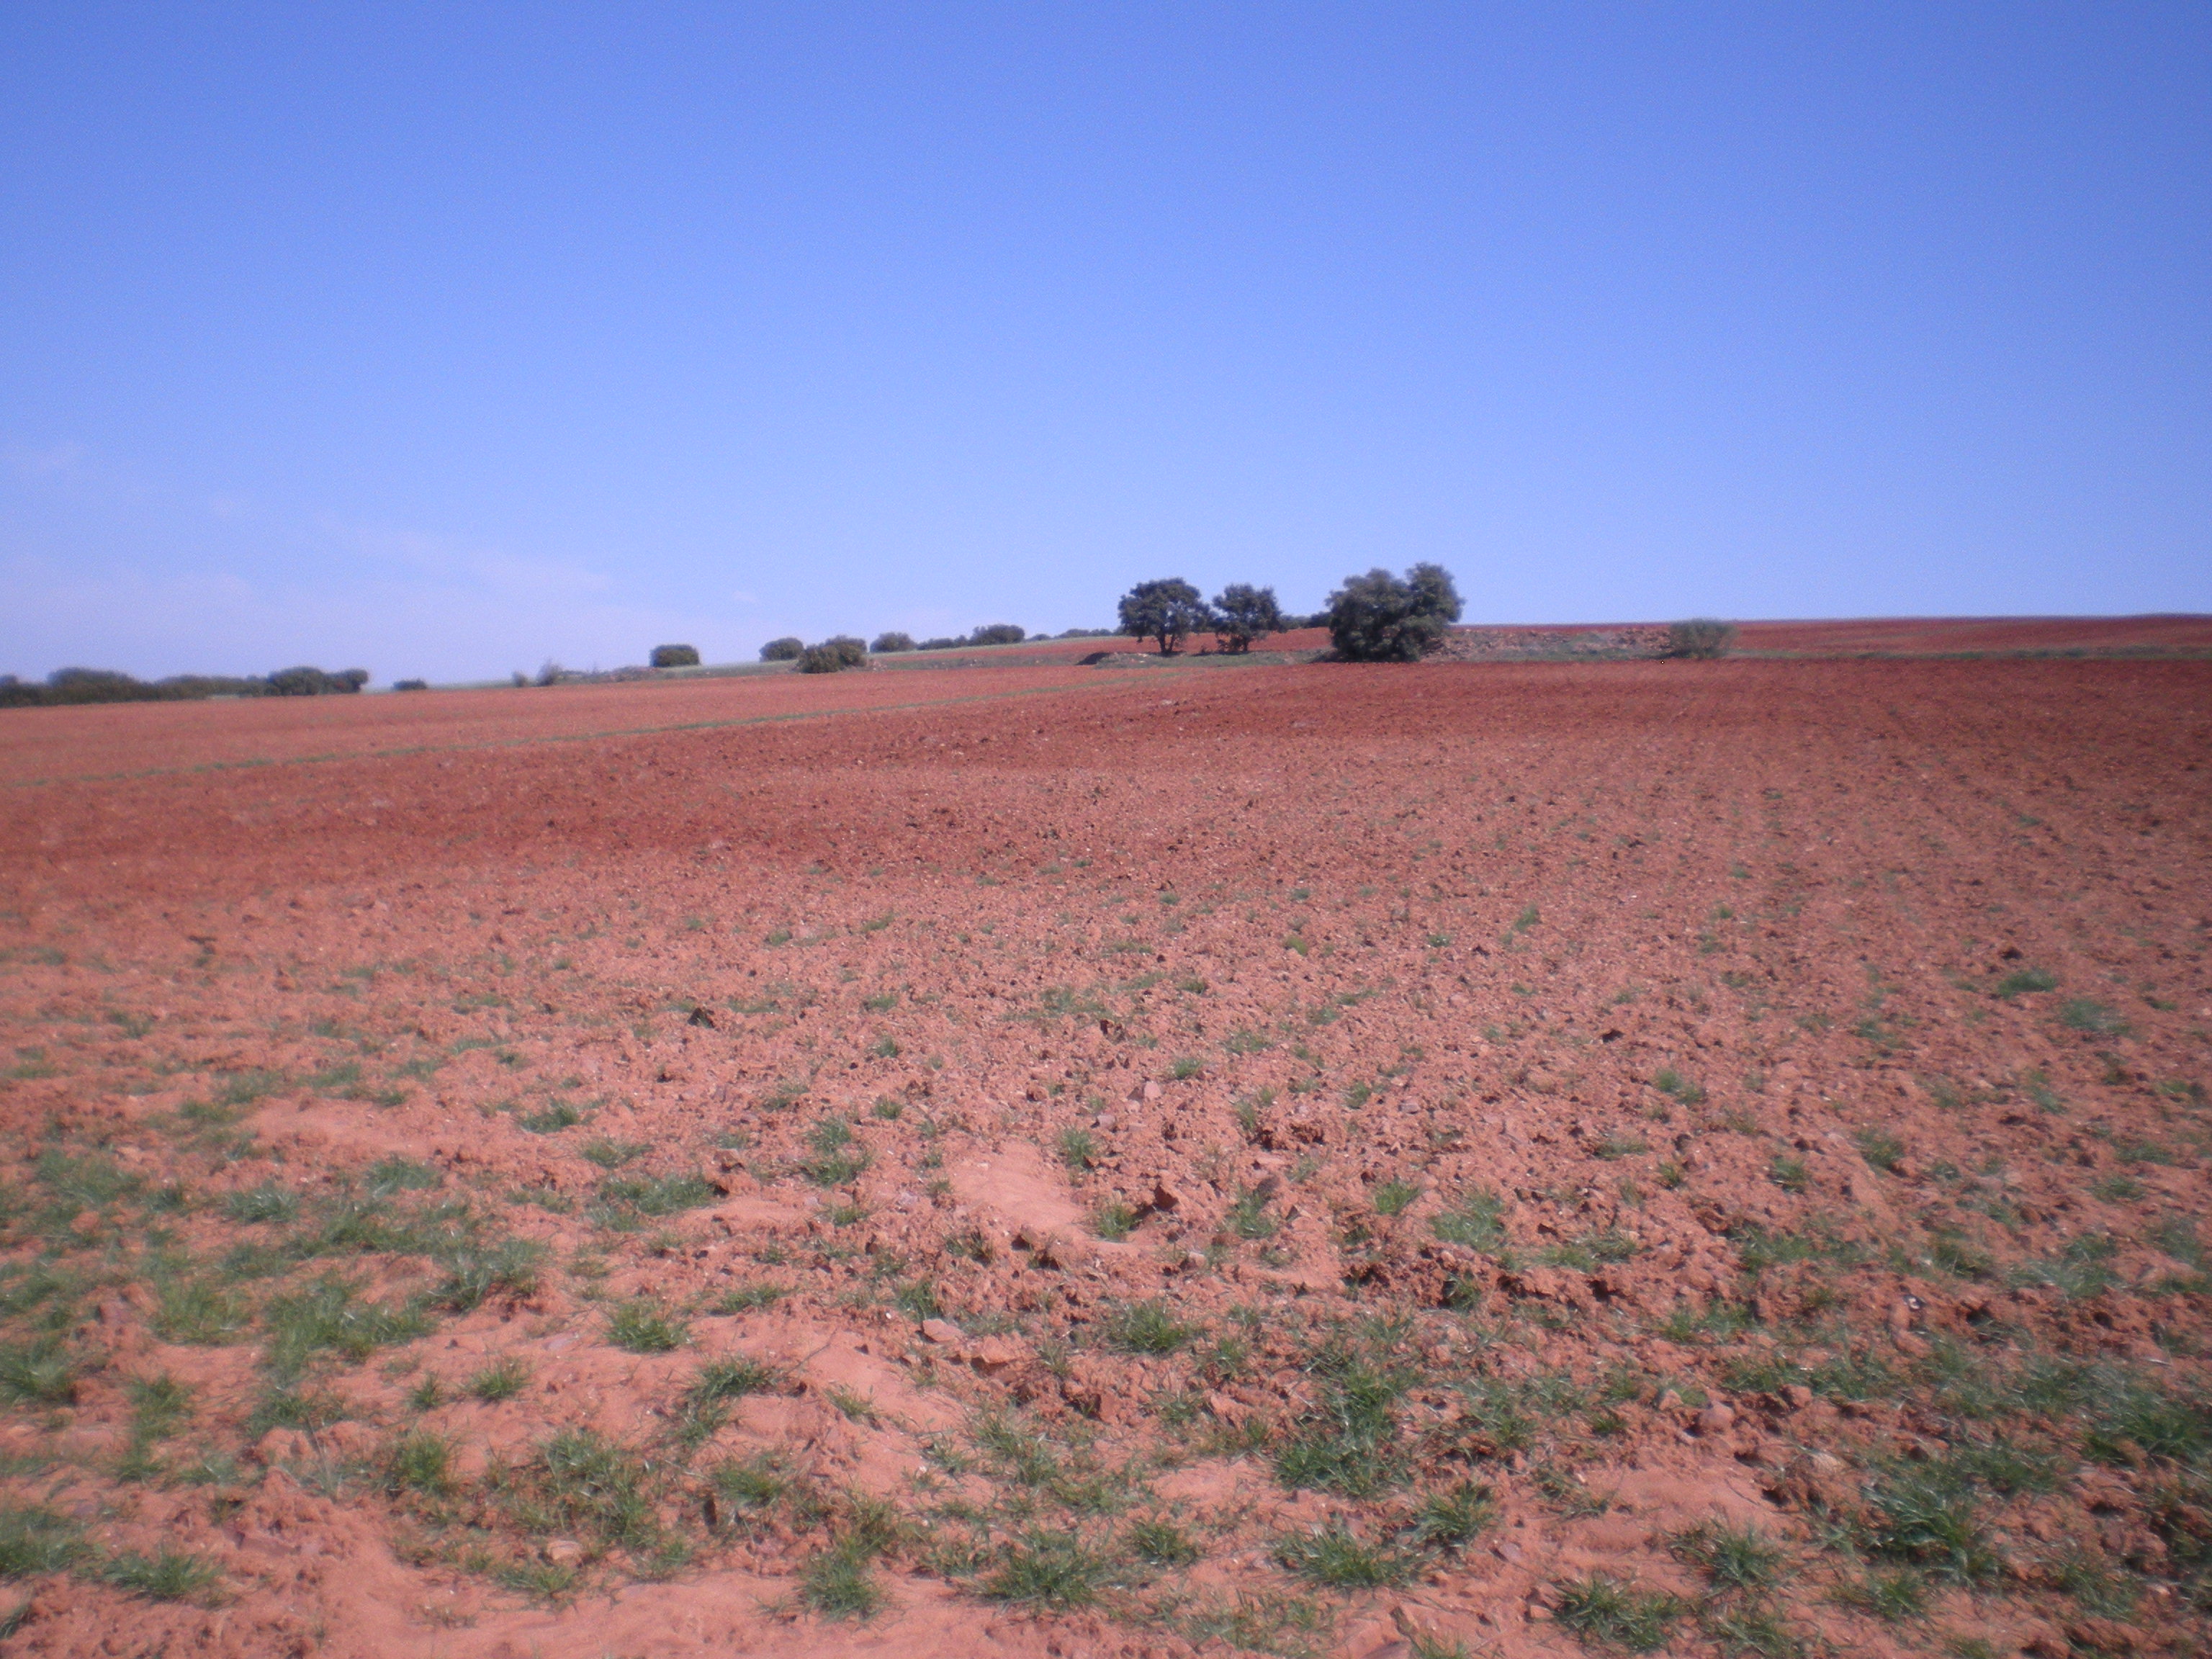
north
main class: Grassland
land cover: Spontaneously vegetated surfaces
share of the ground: 10 - 25 %
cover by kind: unconsolidated bare surface 80 %, herbaceous plants 20 %
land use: Fallow land
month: April
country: ES
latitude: 38.5219
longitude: -3.5089
